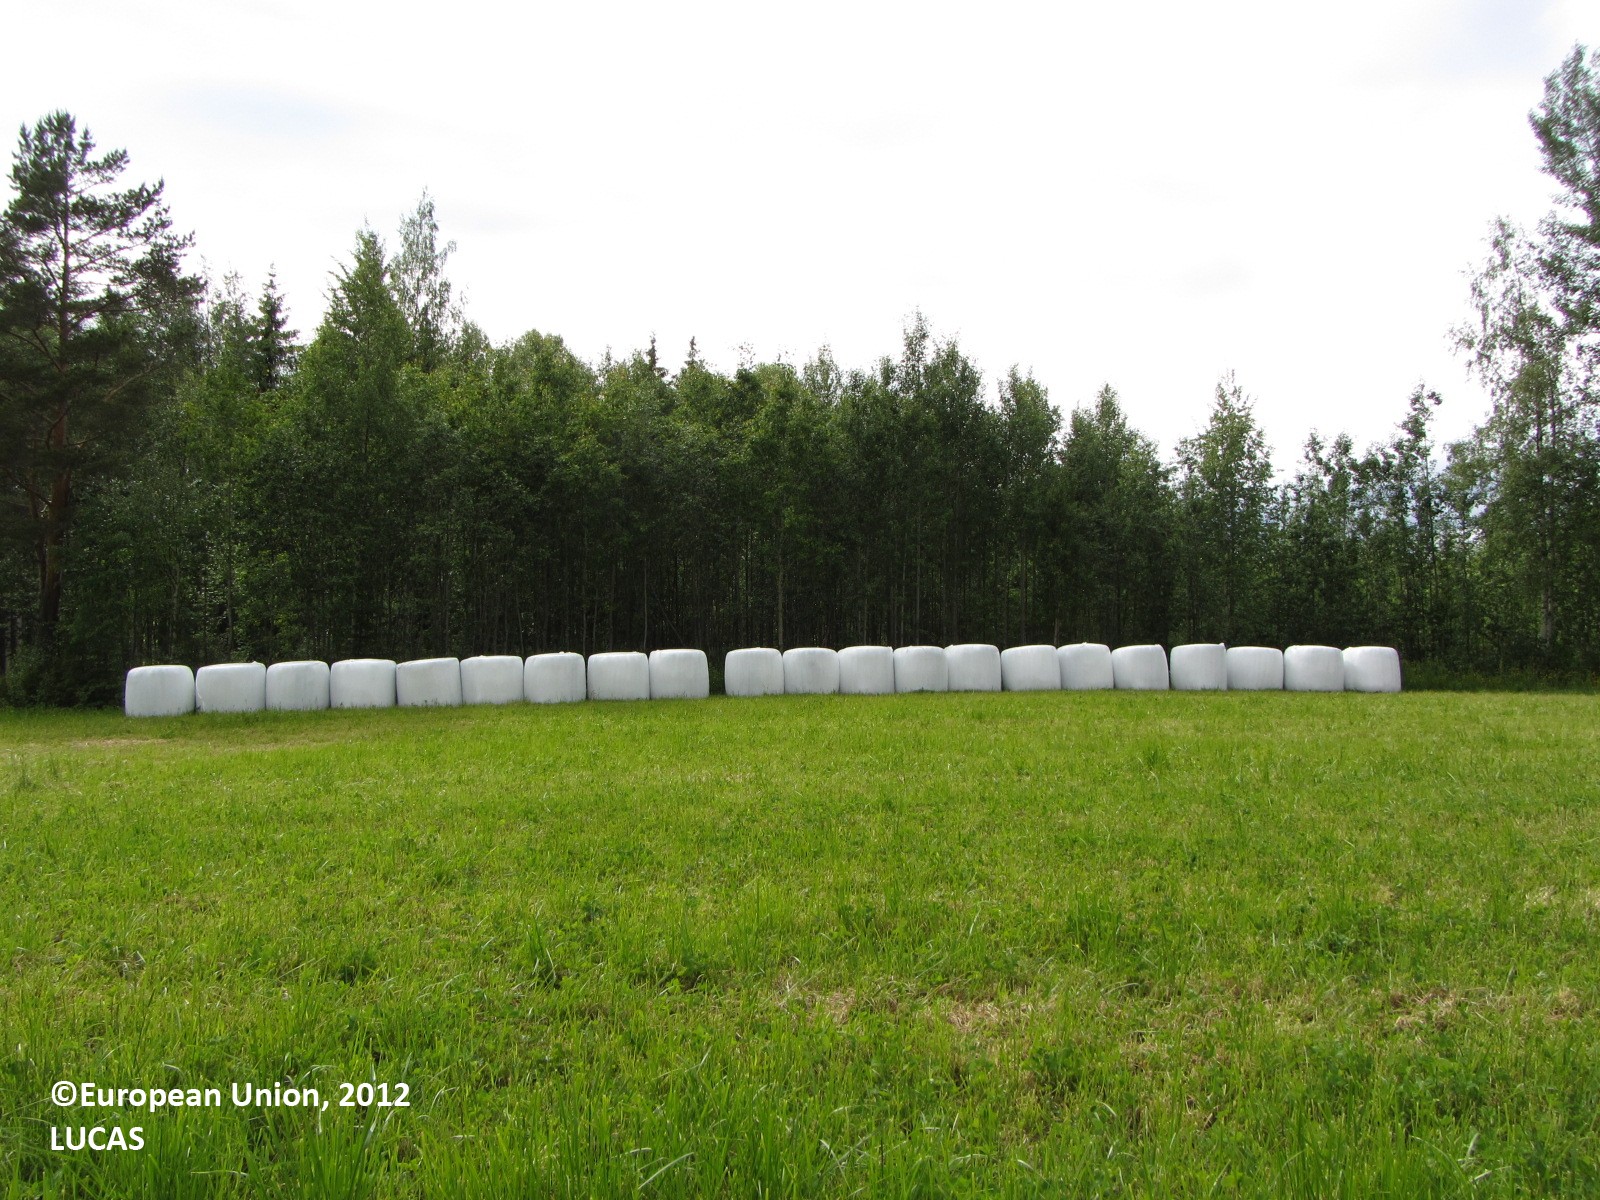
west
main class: Cropland
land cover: Temporary grasslands
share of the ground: > 75 %
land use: Agriculture (excluding fallow land and kitchen gardens)
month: June
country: FI
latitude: 62.7888
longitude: 25.4163
